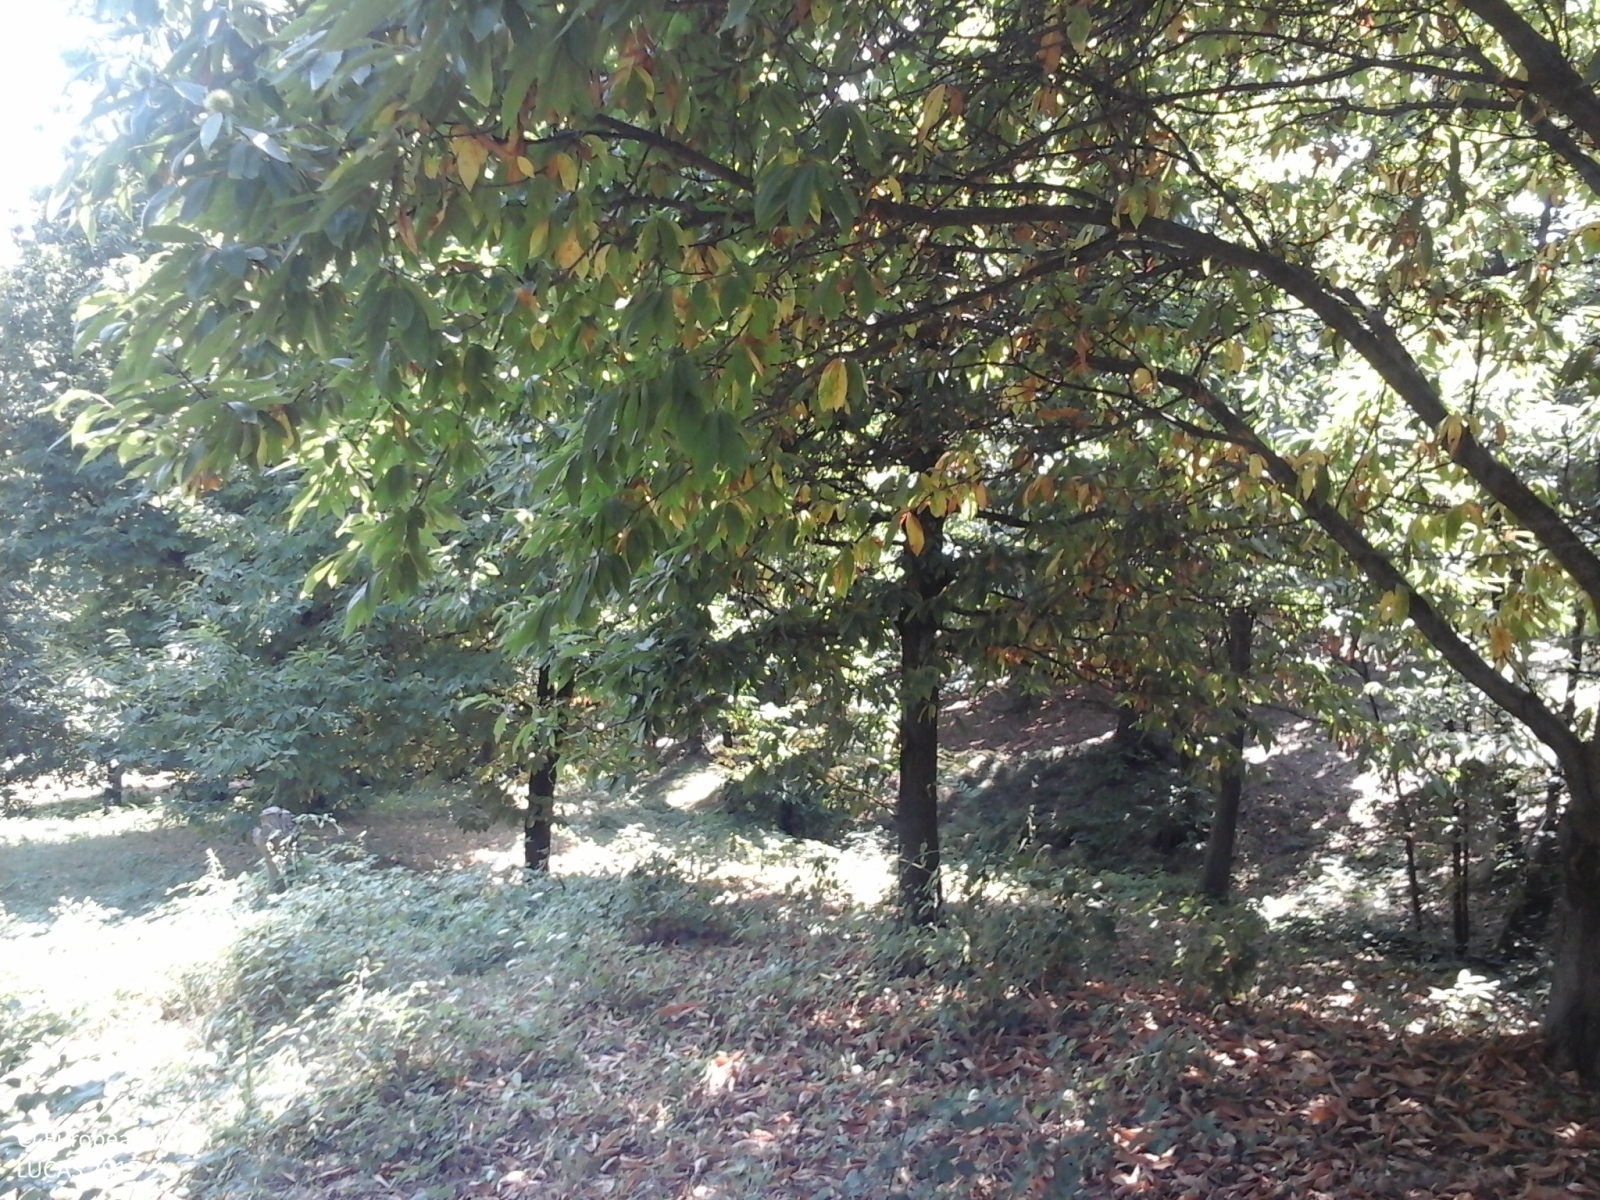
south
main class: Woodland
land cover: Broadleaved woodland
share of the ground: > 75 %
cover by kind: broadleaved forest trees 70 %, herbaceous plants 30 %
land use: Agriculture (excluding fallow land and kitchen gardens)
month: August
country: IT
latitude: 44.3275
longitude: 7.8103
